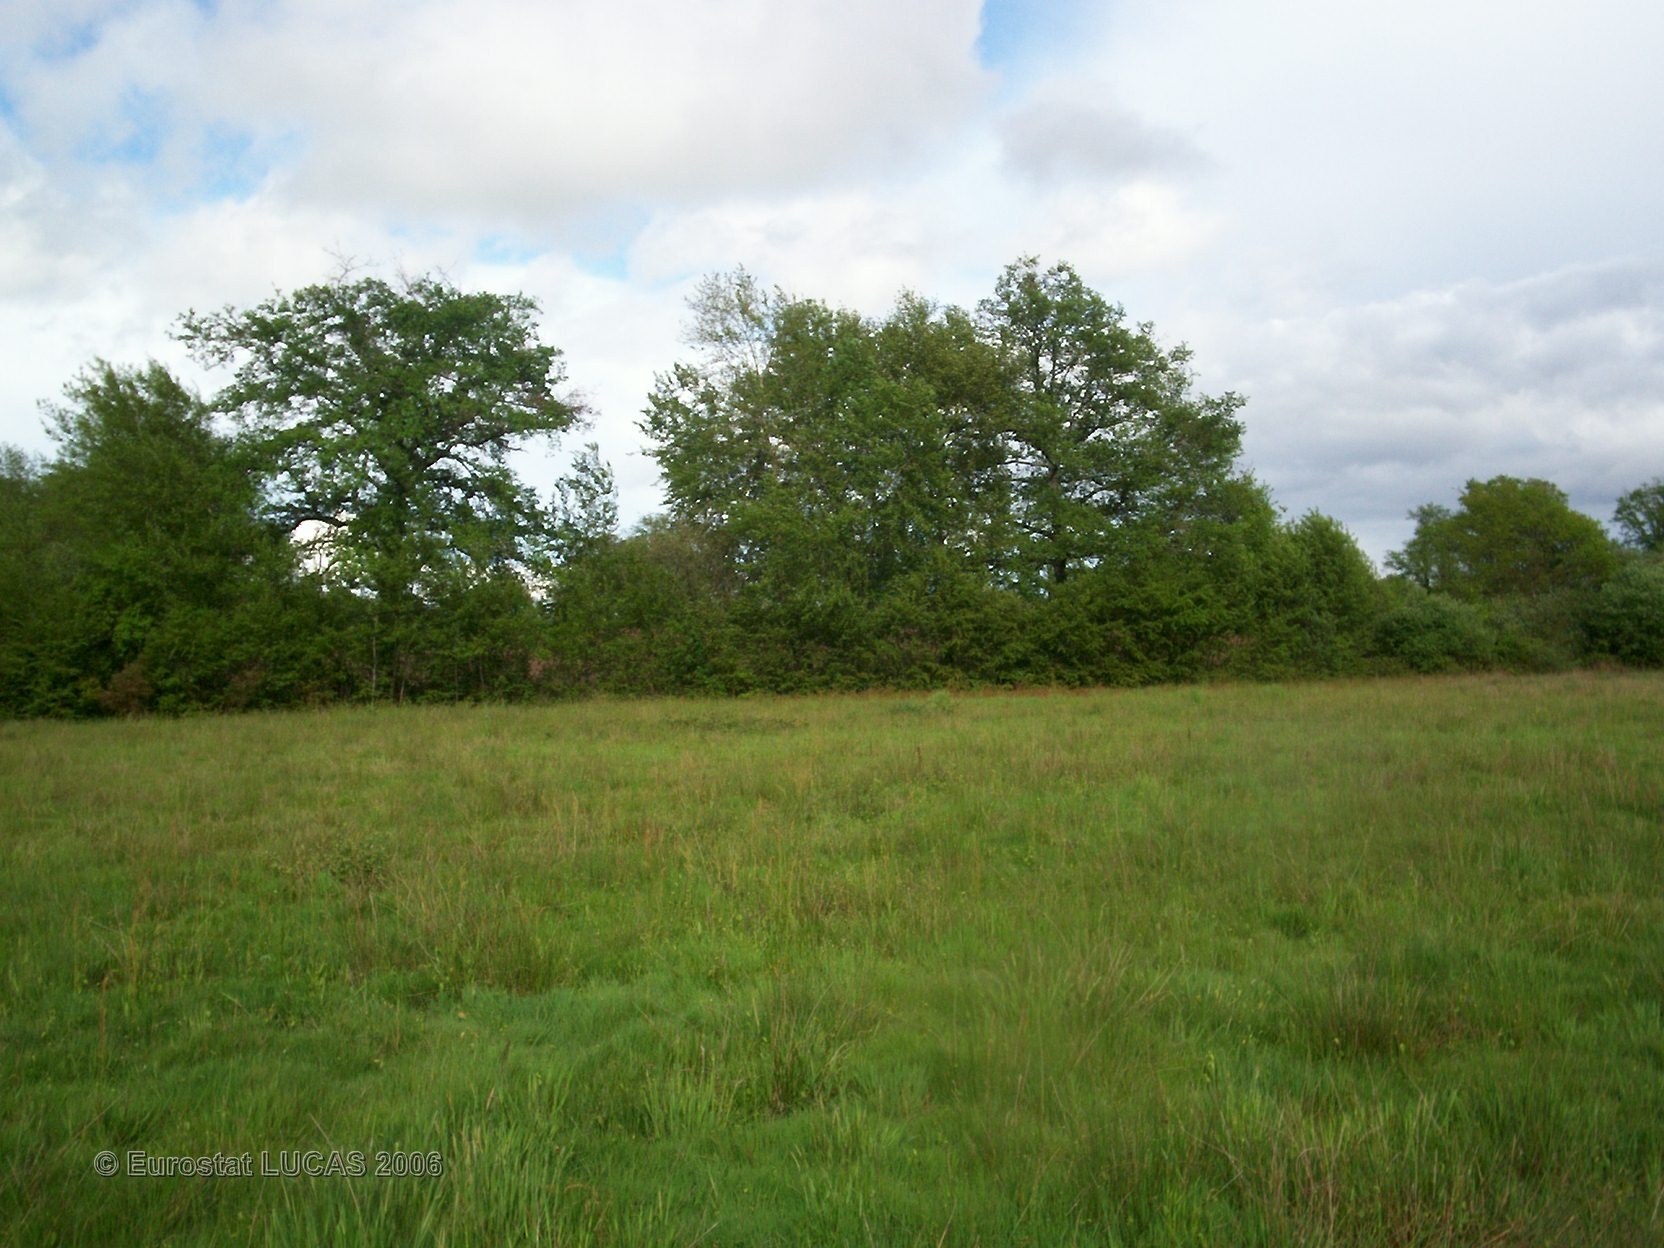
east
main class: Grassland
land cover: Grassland without tree/shrub cover
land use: Agriculture (excluding fallow land and kitchen gardens)
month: May
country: FR
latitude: 45.9304
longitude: 0.5323
